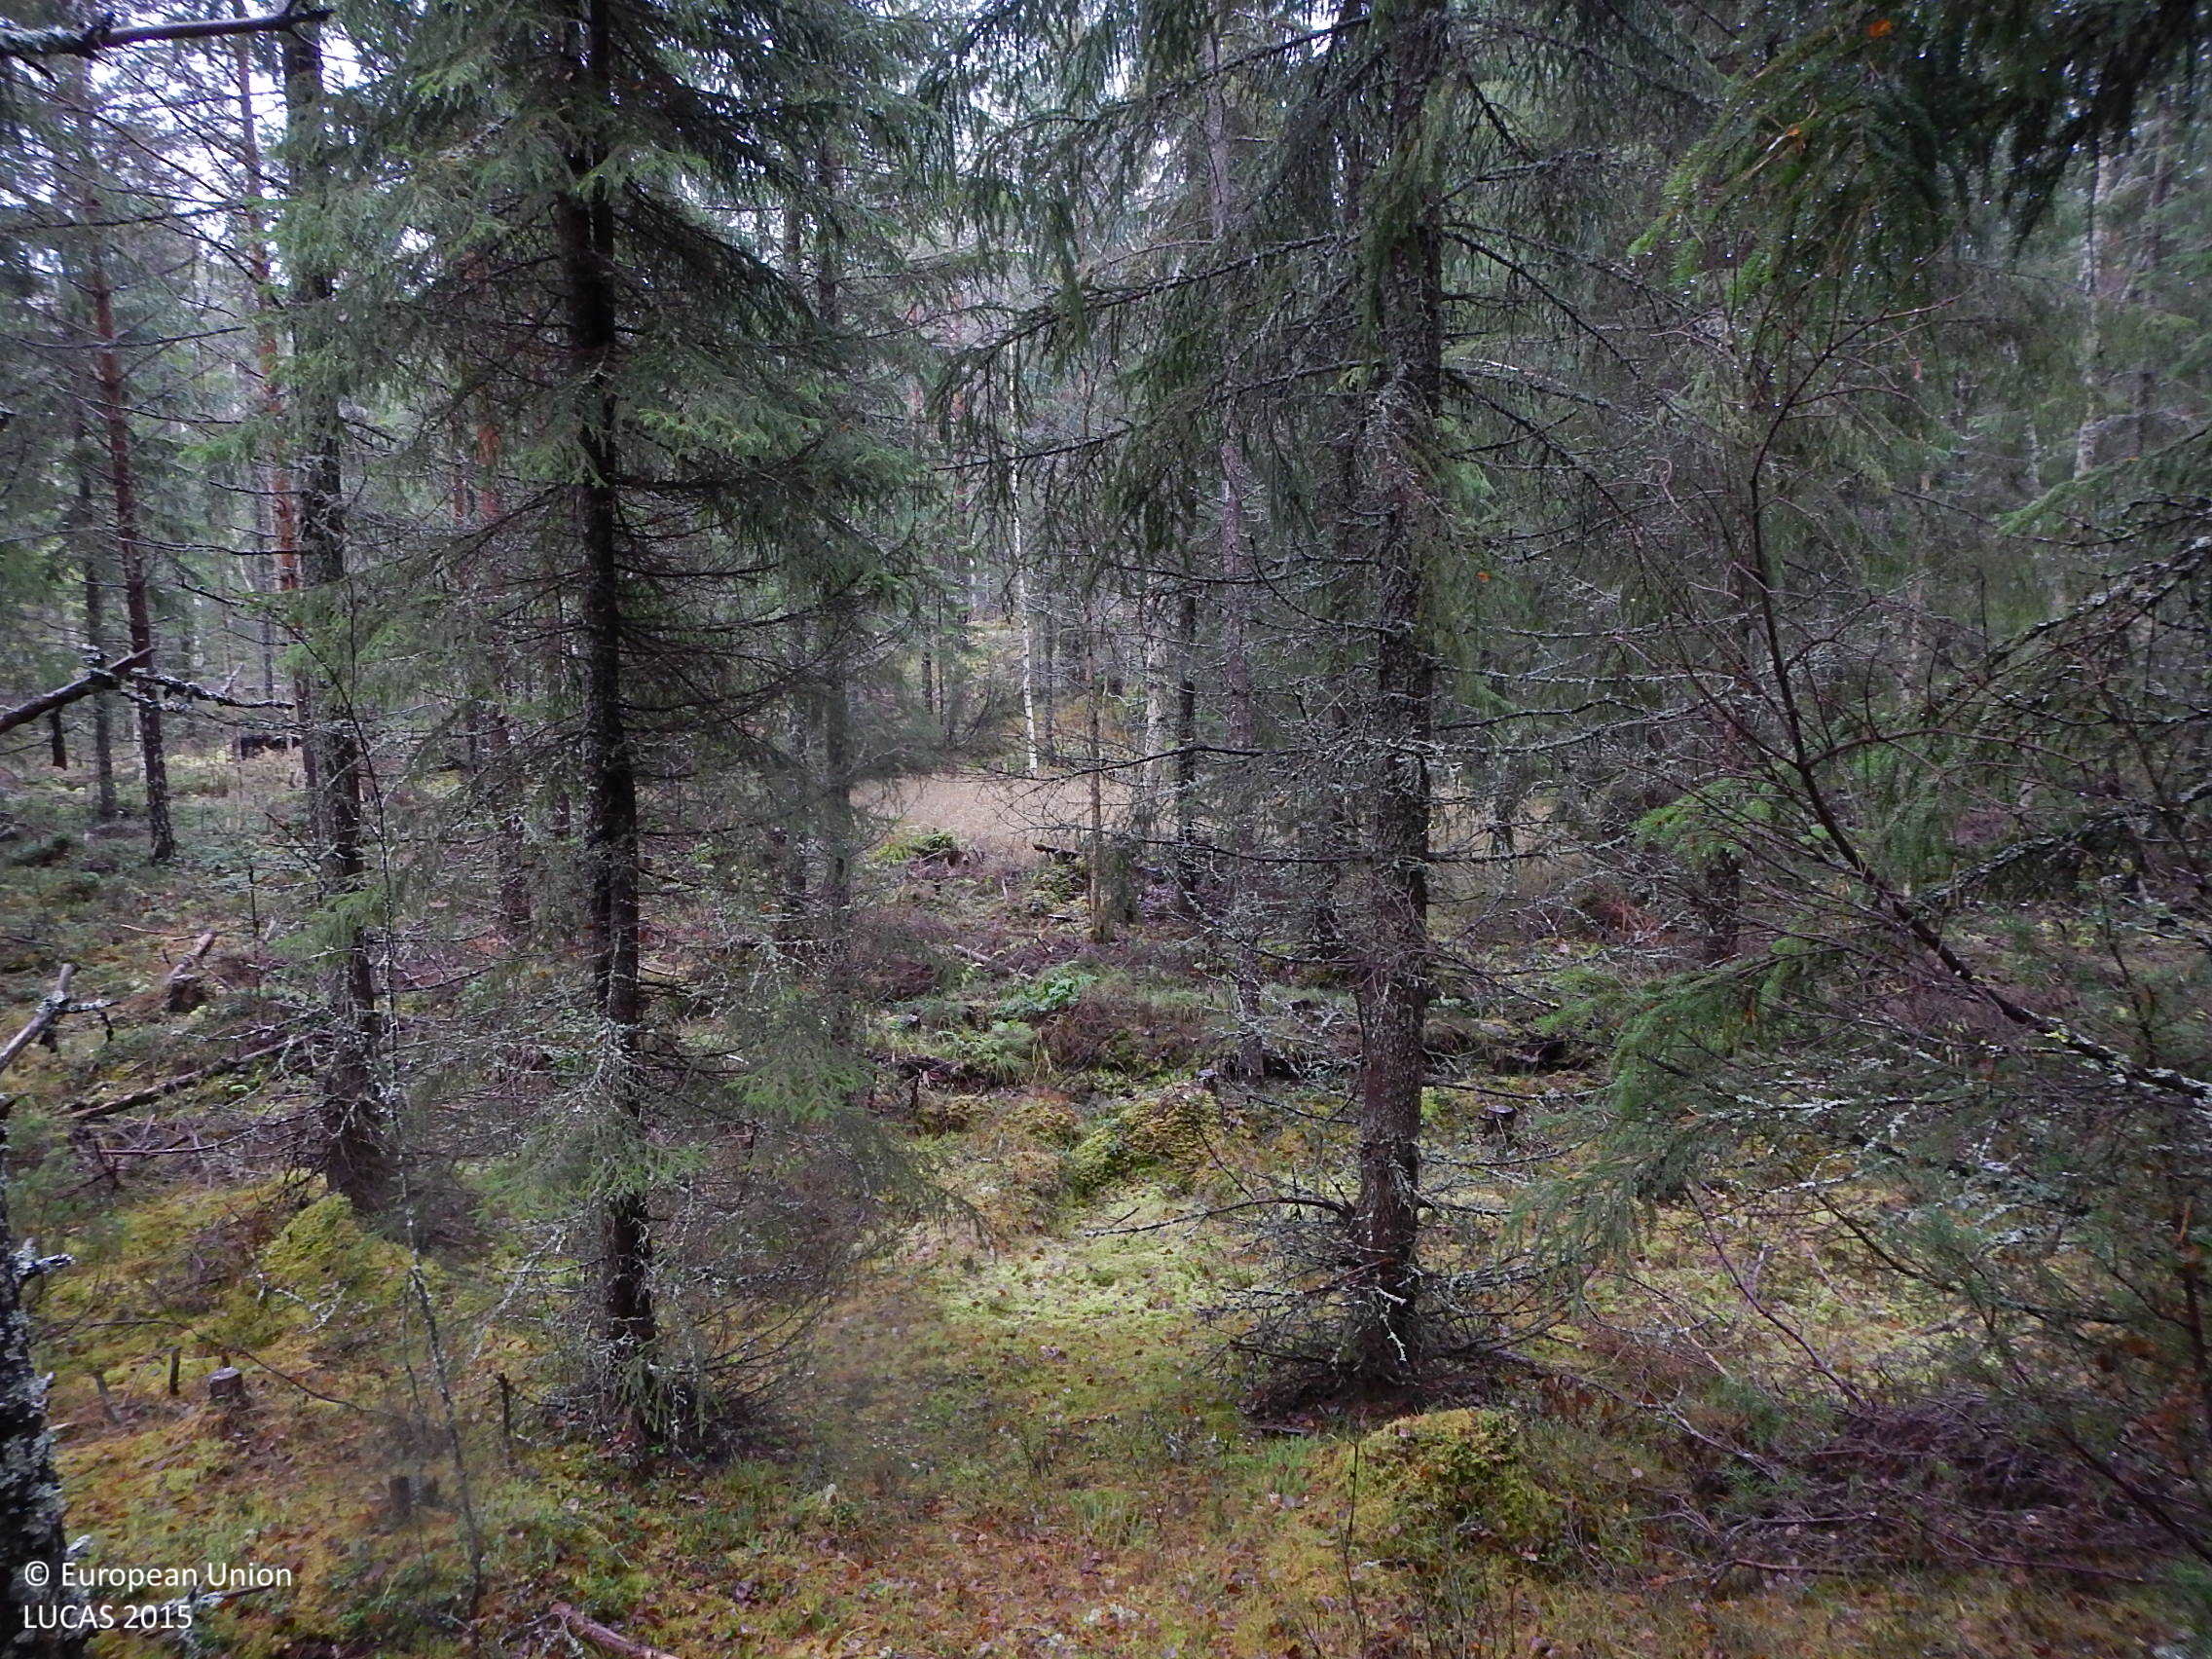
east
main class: Woodland
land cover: Other mixed woodland
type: boreal forest
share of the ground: > 75 %
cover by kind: coniferous forest trees 45 %, broadleaved forest trees 30 %, shrubs 10 %, lichens and mosses 10 %, herbaceous plants 5 %
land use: Forestry
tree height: > 5 m
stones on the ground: < 10 %
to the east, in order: Other mixed woodland; Tracks; Spruce dominated coniferous woodland; Tracks; Other mixed woodland; Tracks; Other mixed woodland; Pine dominated coniferous woodland; Pine dominated mixed woodland; Spruce dominated mixed woodland
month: November
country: SE
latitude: 61.3774
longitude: 16.7029
